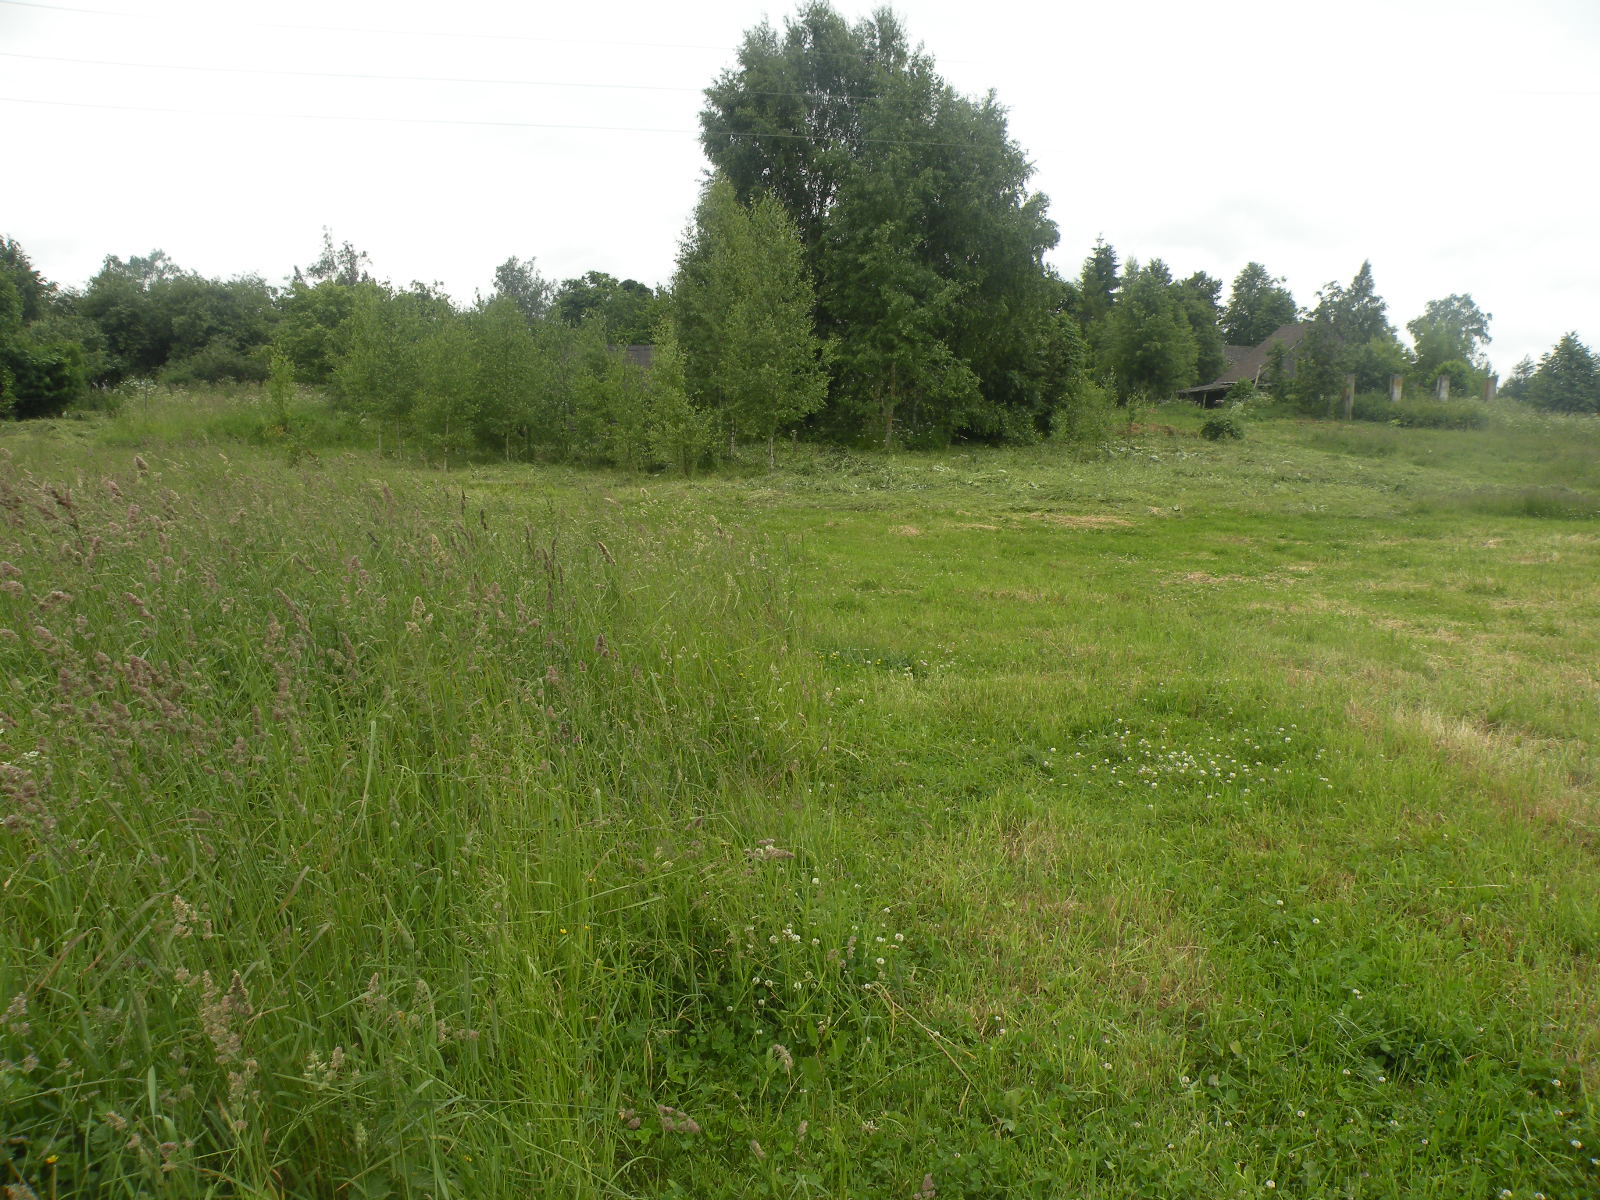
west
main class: Grassland
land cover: Grassland without tree/shrub cover
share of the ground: > 75 %
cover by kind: herbaceous plants 100 %
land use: Agriculture (excluding fallow land and kitchen gardens)
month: June
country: LV
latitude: 56.0425
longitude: 26.6730
